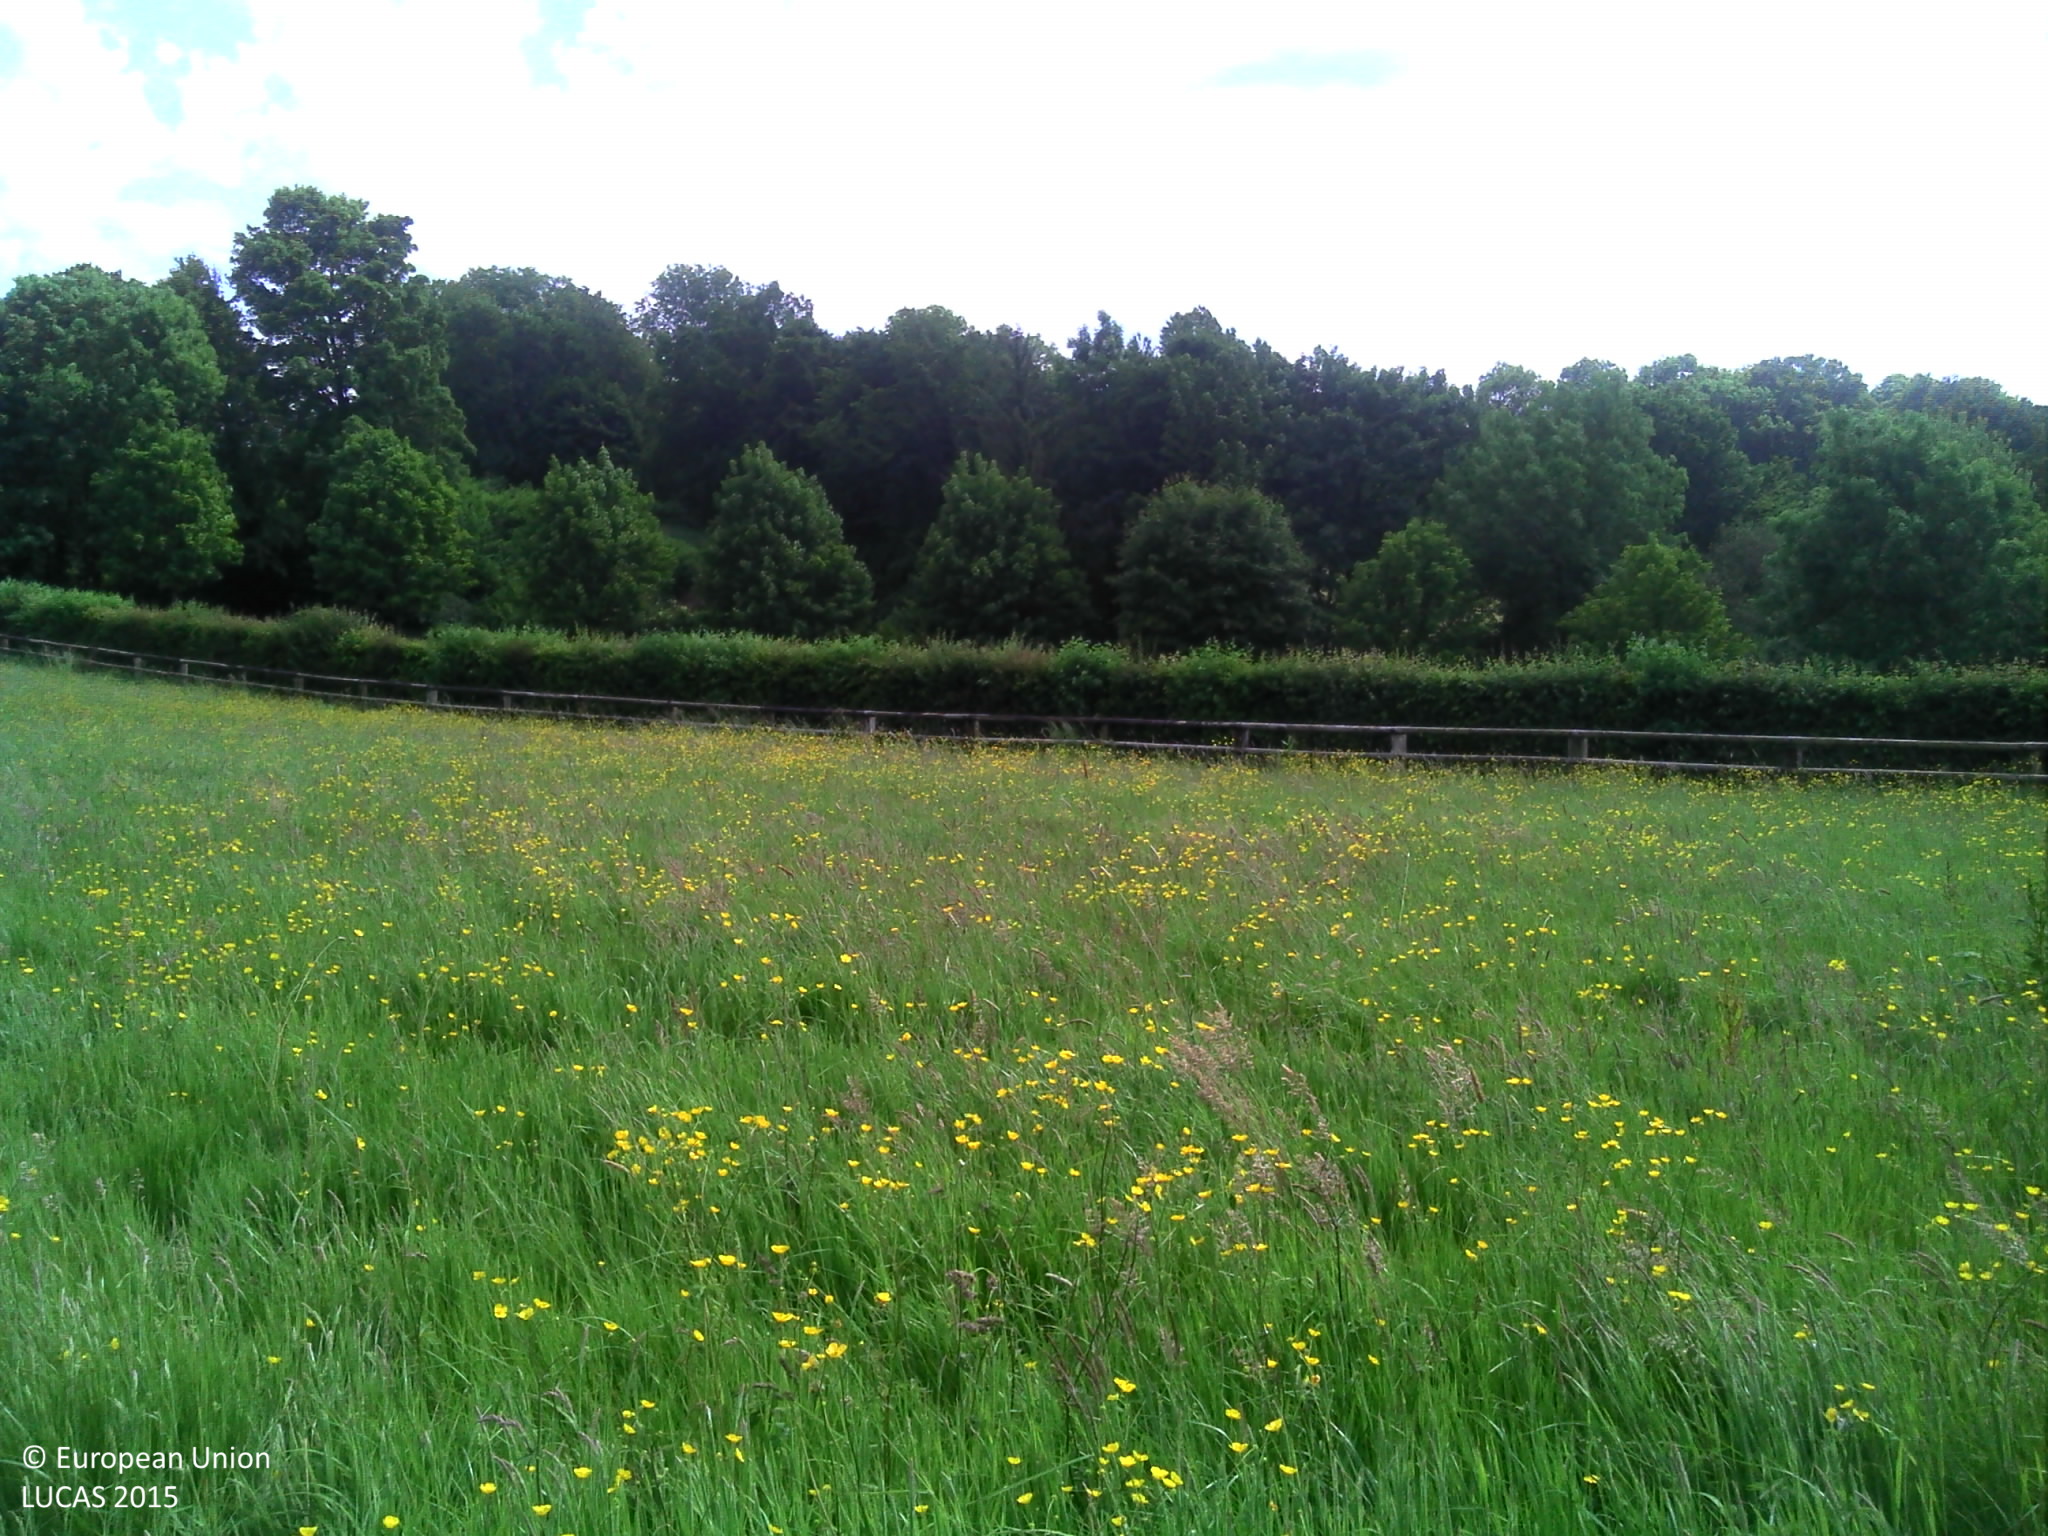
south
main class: Grassland
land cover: Grassland without tree/shrub cover
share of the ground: > 75 %
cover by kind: herbaceous plants 95 %
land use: Agriculture (excluding fallow land and kitchen gardens)
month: June
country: FR
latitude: 48.7257
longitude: 0.1701
